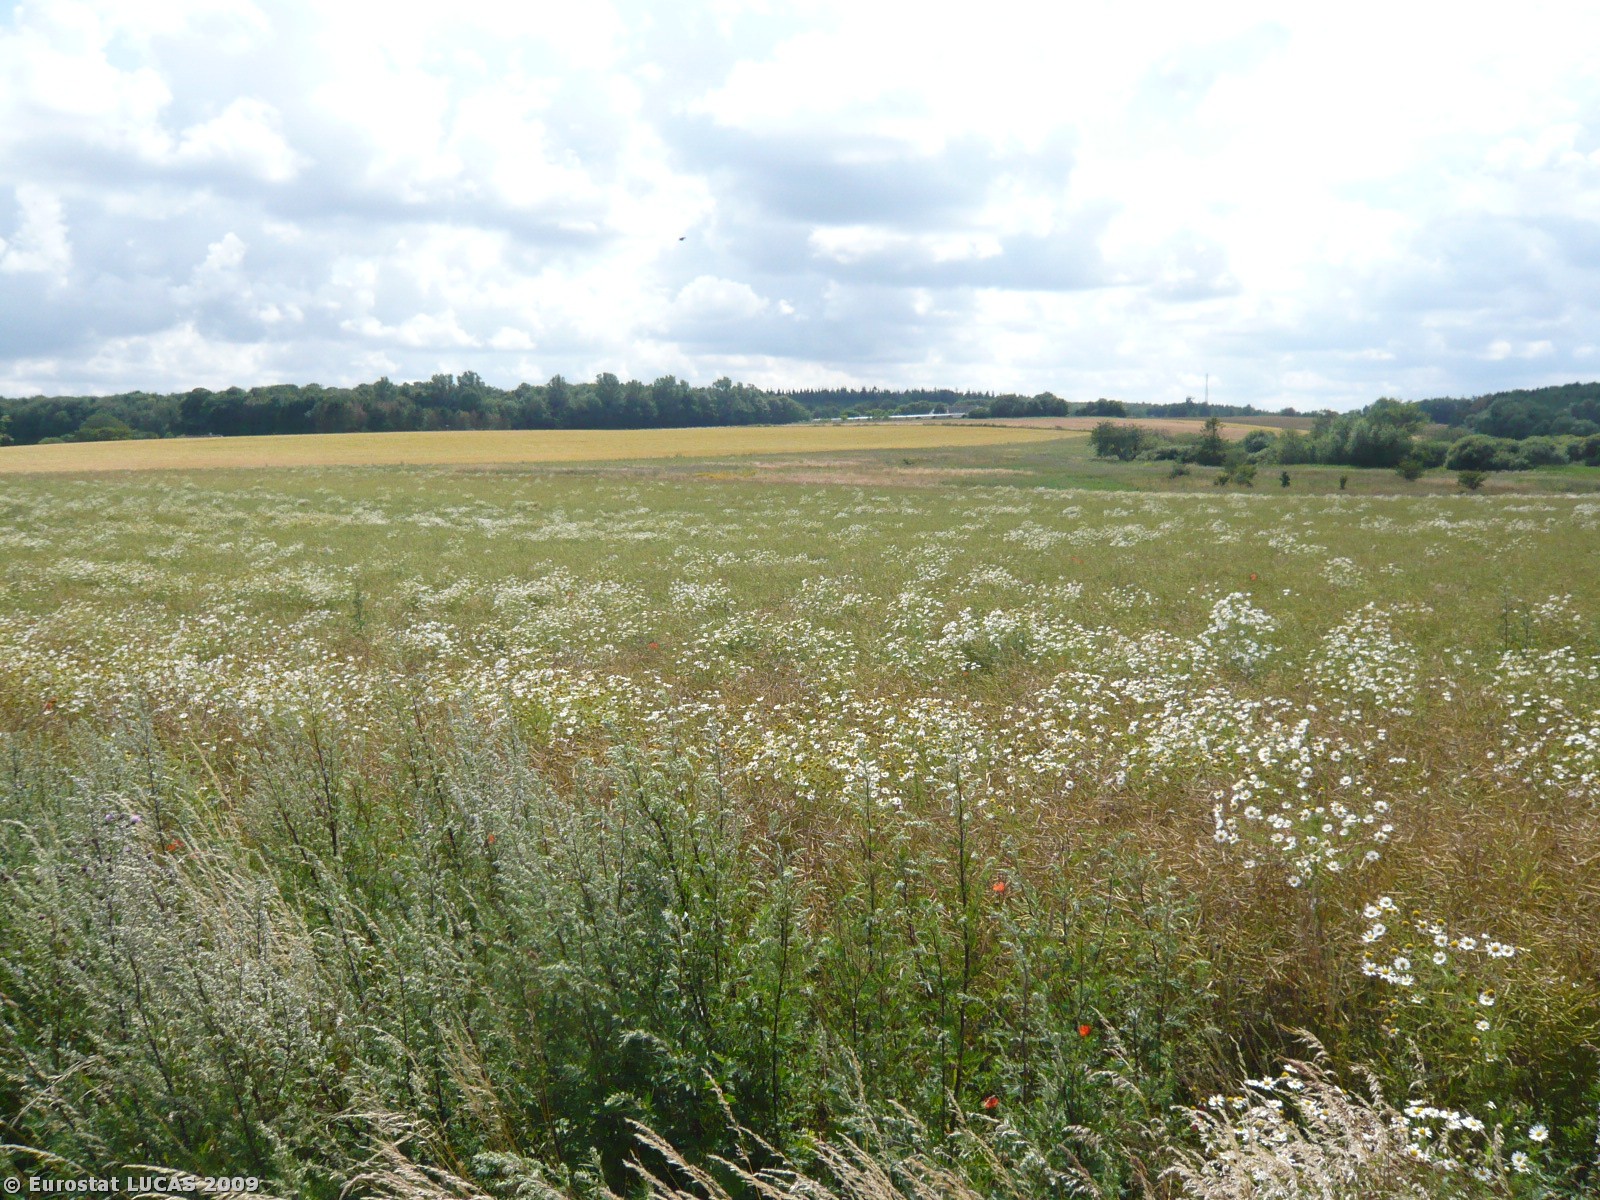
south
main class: Cropland
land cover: Rape and turnip rape
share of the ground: > 75 %
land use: Agriculture (excluding fallow land and kitchen gardens)
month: July
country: DK
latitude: 55.5092
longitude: 11.8511
